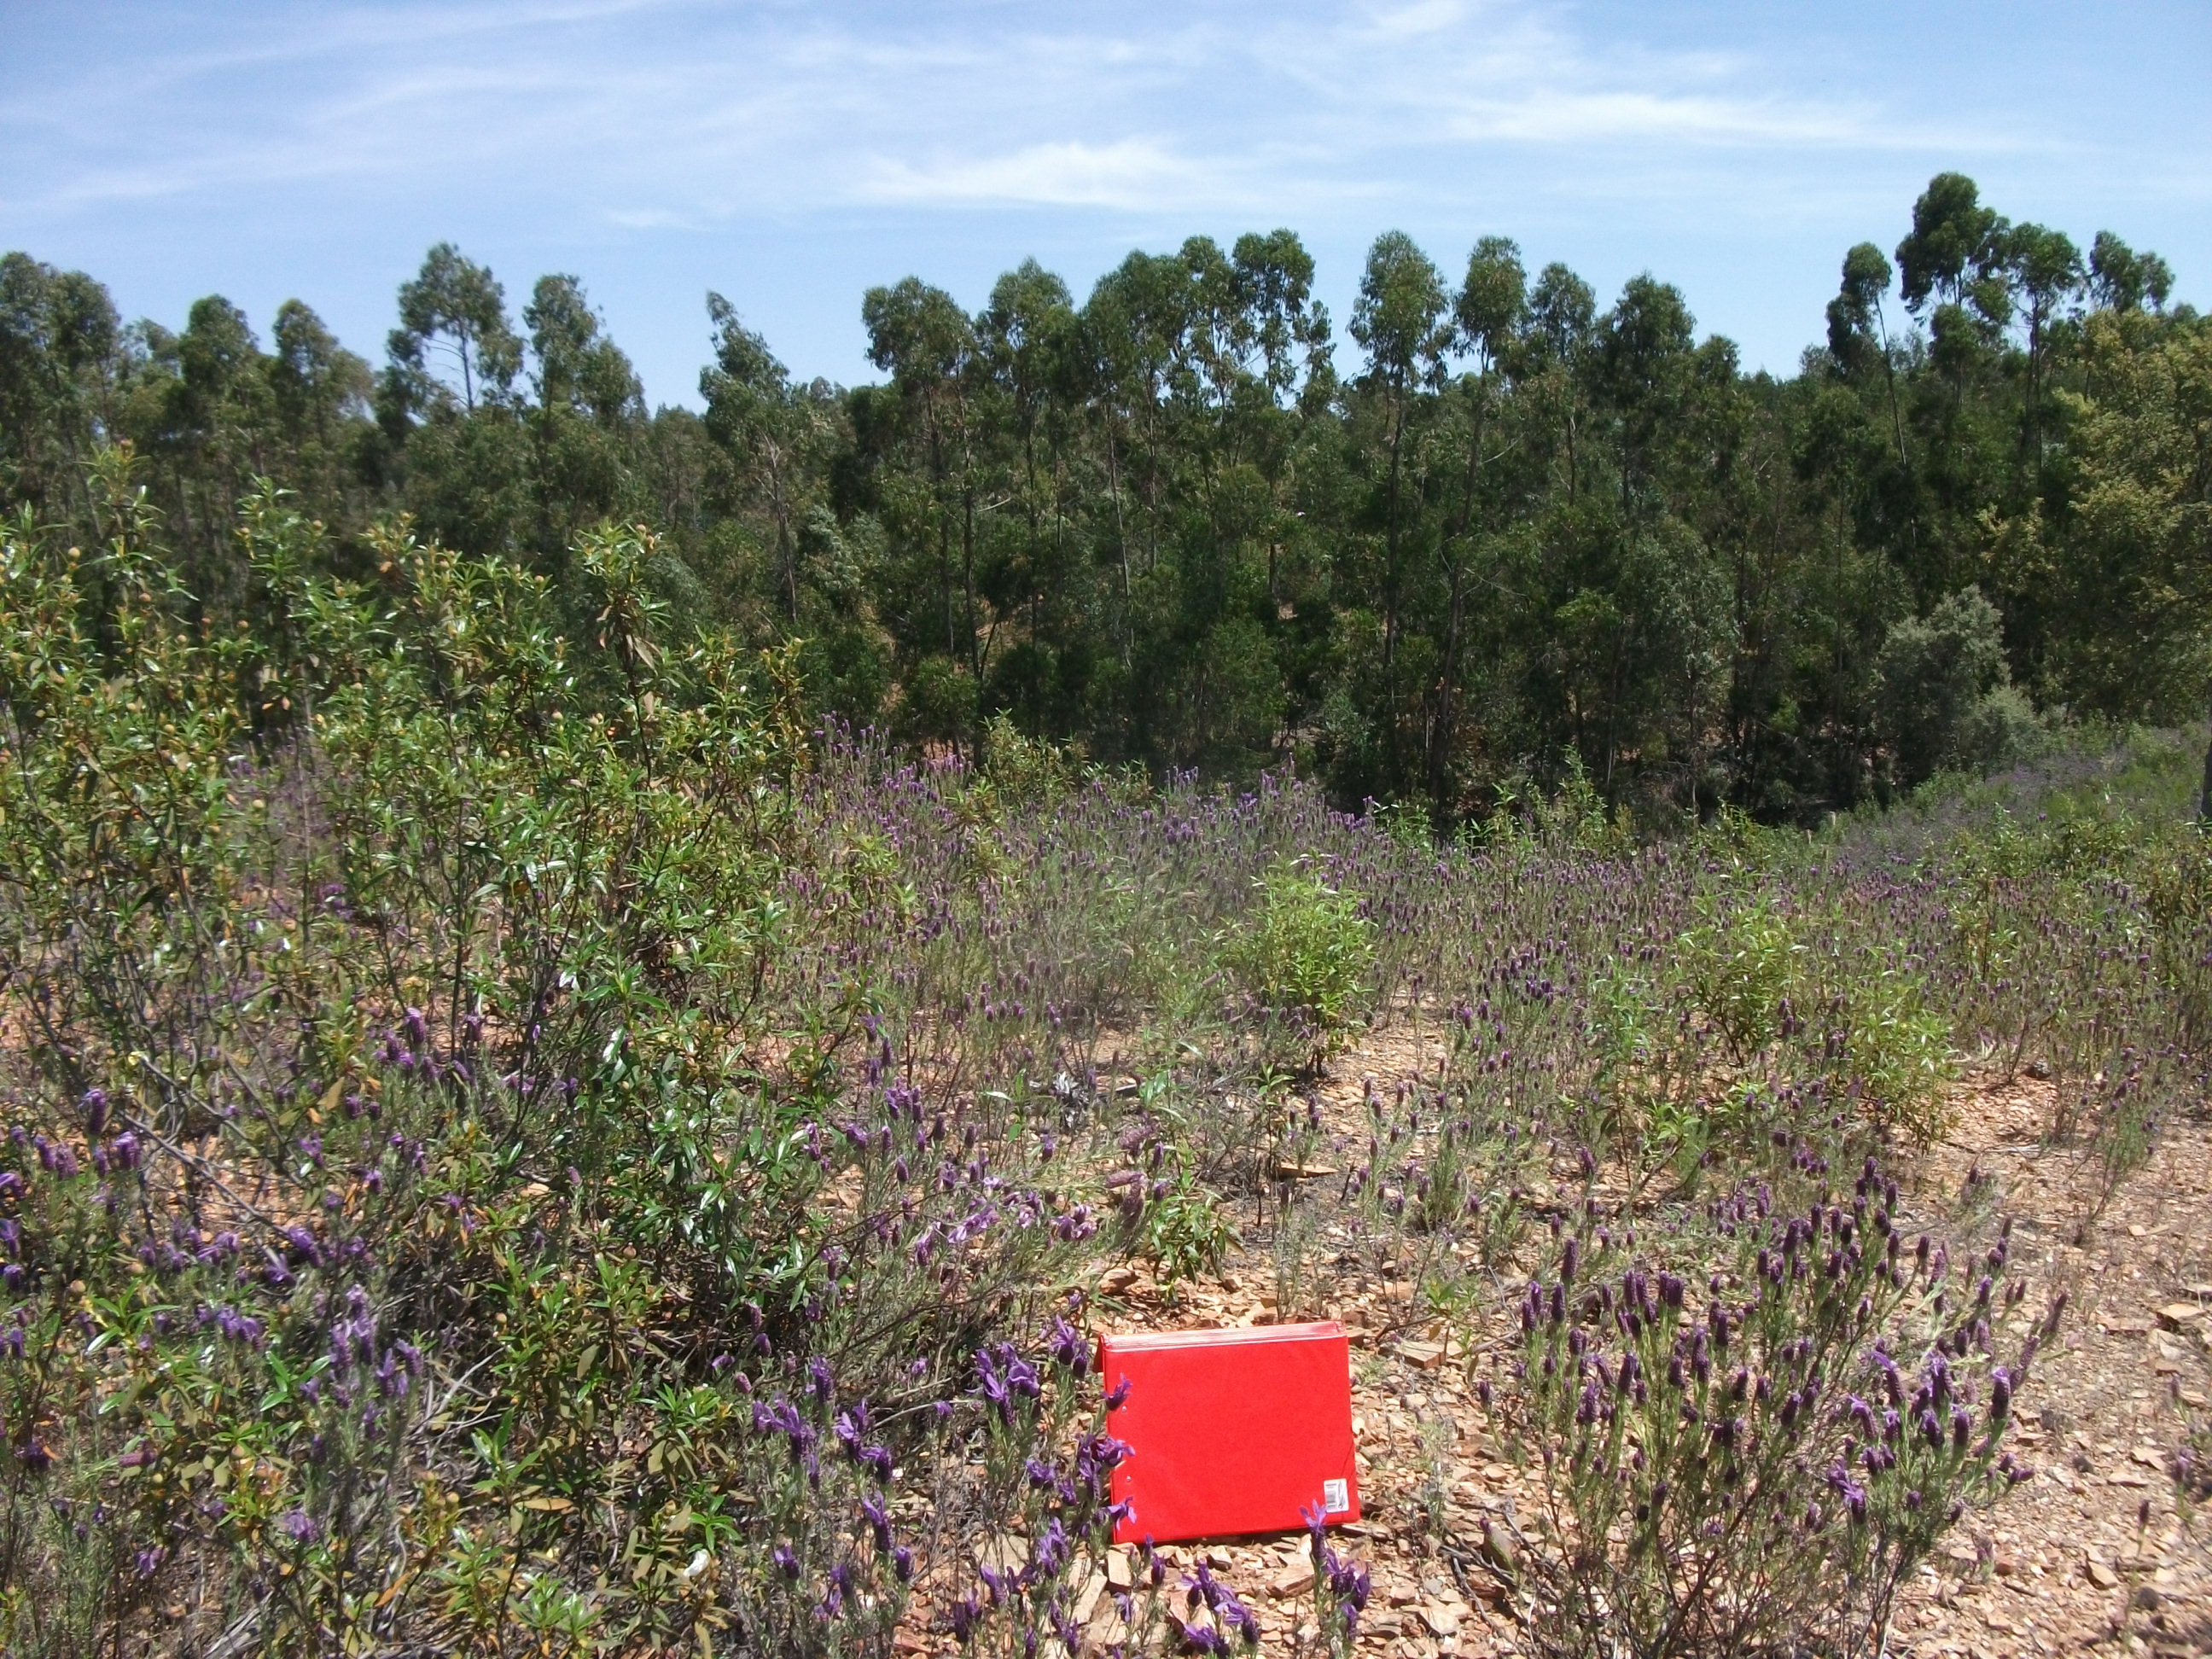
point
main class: Woodland
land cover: Broadleaved woodland
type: broadleaved evergreen forest
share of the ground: 10 - 25 %
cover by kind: shrubs 90 %, broadleaved forest trees 10 %
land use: Forestry
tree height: < 5 m
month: May
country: ES
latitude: 37.8484
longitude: -7.2044
